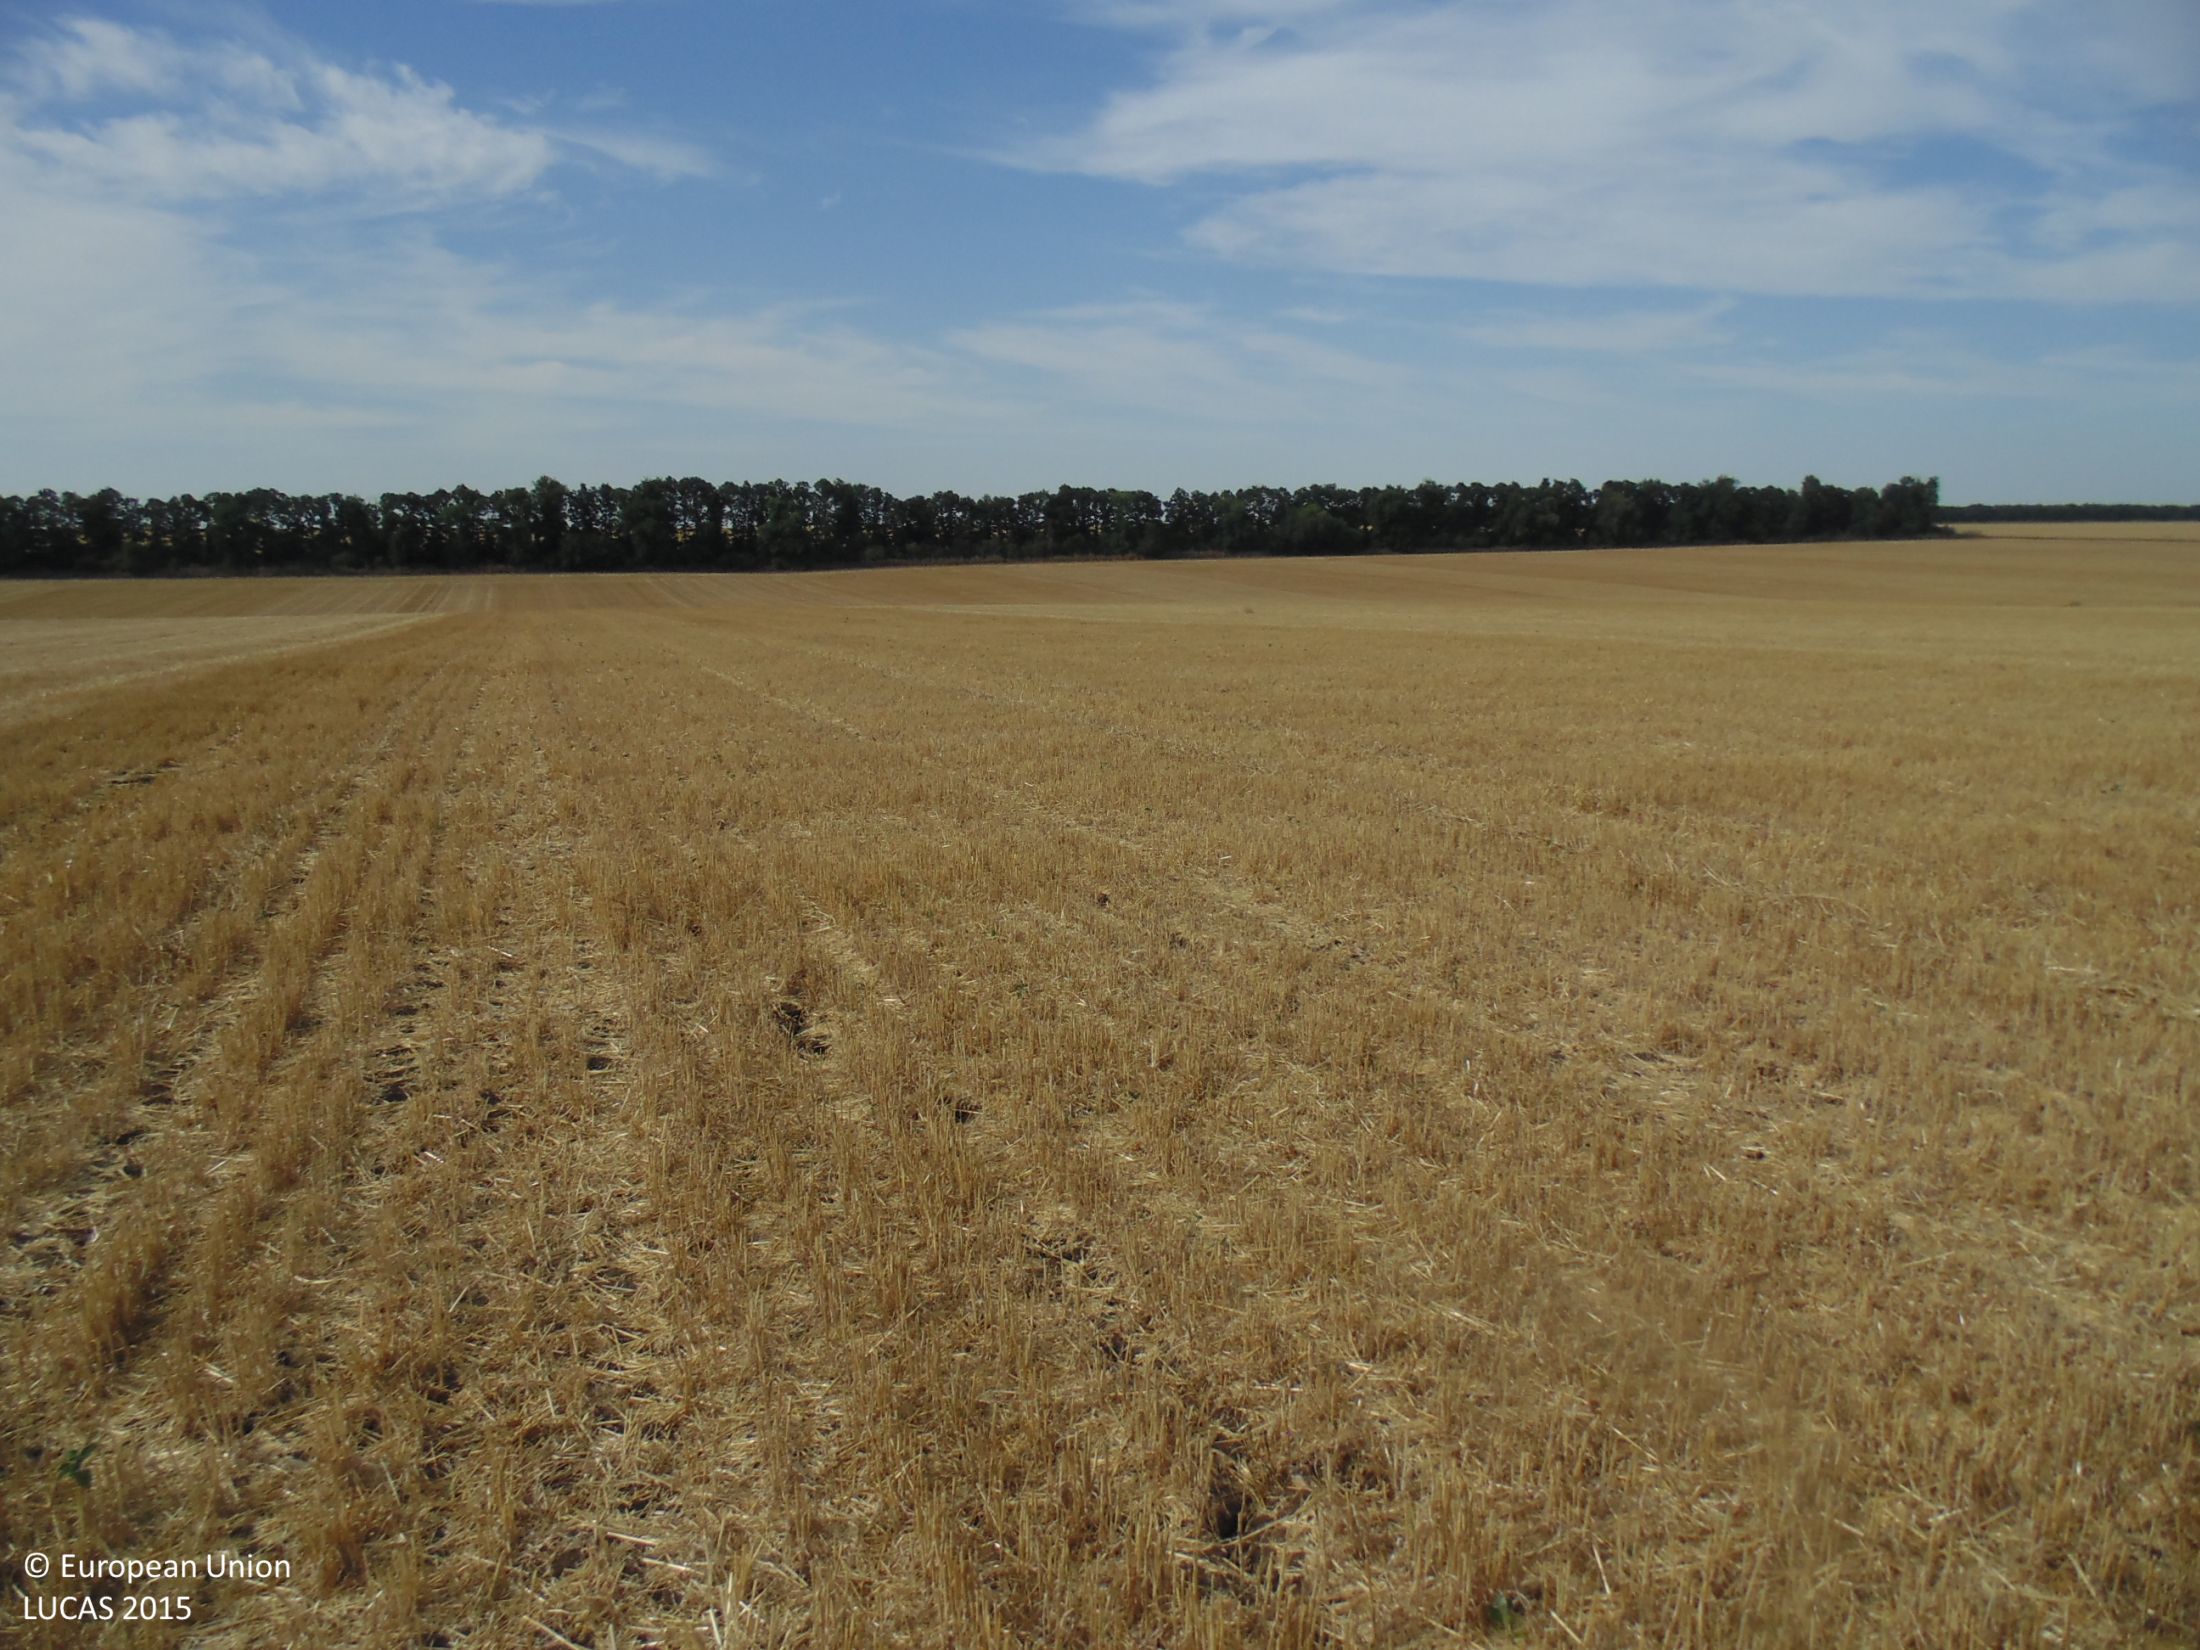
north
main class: Cropland
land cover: Common wheat
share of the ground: 25 - 50 %
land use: Agriculture (excluding fallow land and kitchen gardens)
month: August
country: BG
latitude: 43.6396
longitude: 28.3429
